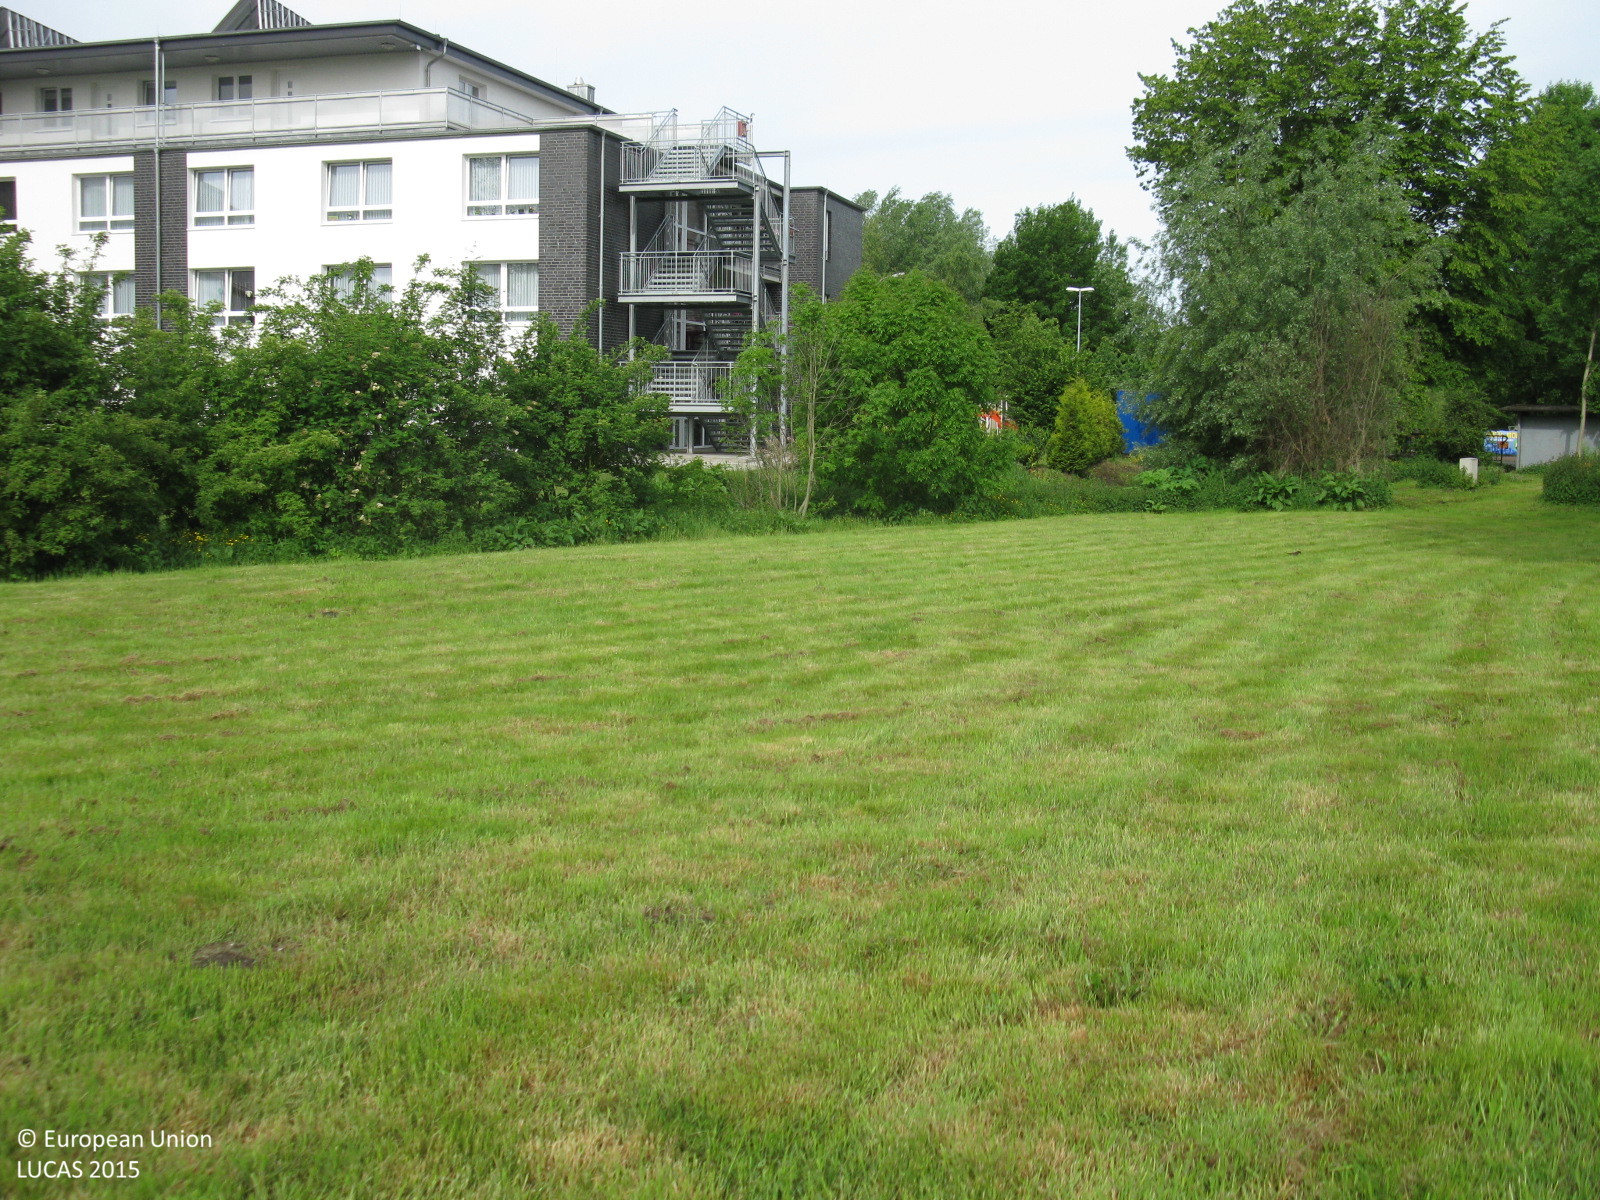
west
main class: Grassland
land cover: Grassland without tree/shrub cover
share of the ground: > 75 %
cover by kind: herbaceous plants 100 %
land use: Residential
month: June
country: DE
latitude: 53.0488
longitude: 7.3303
